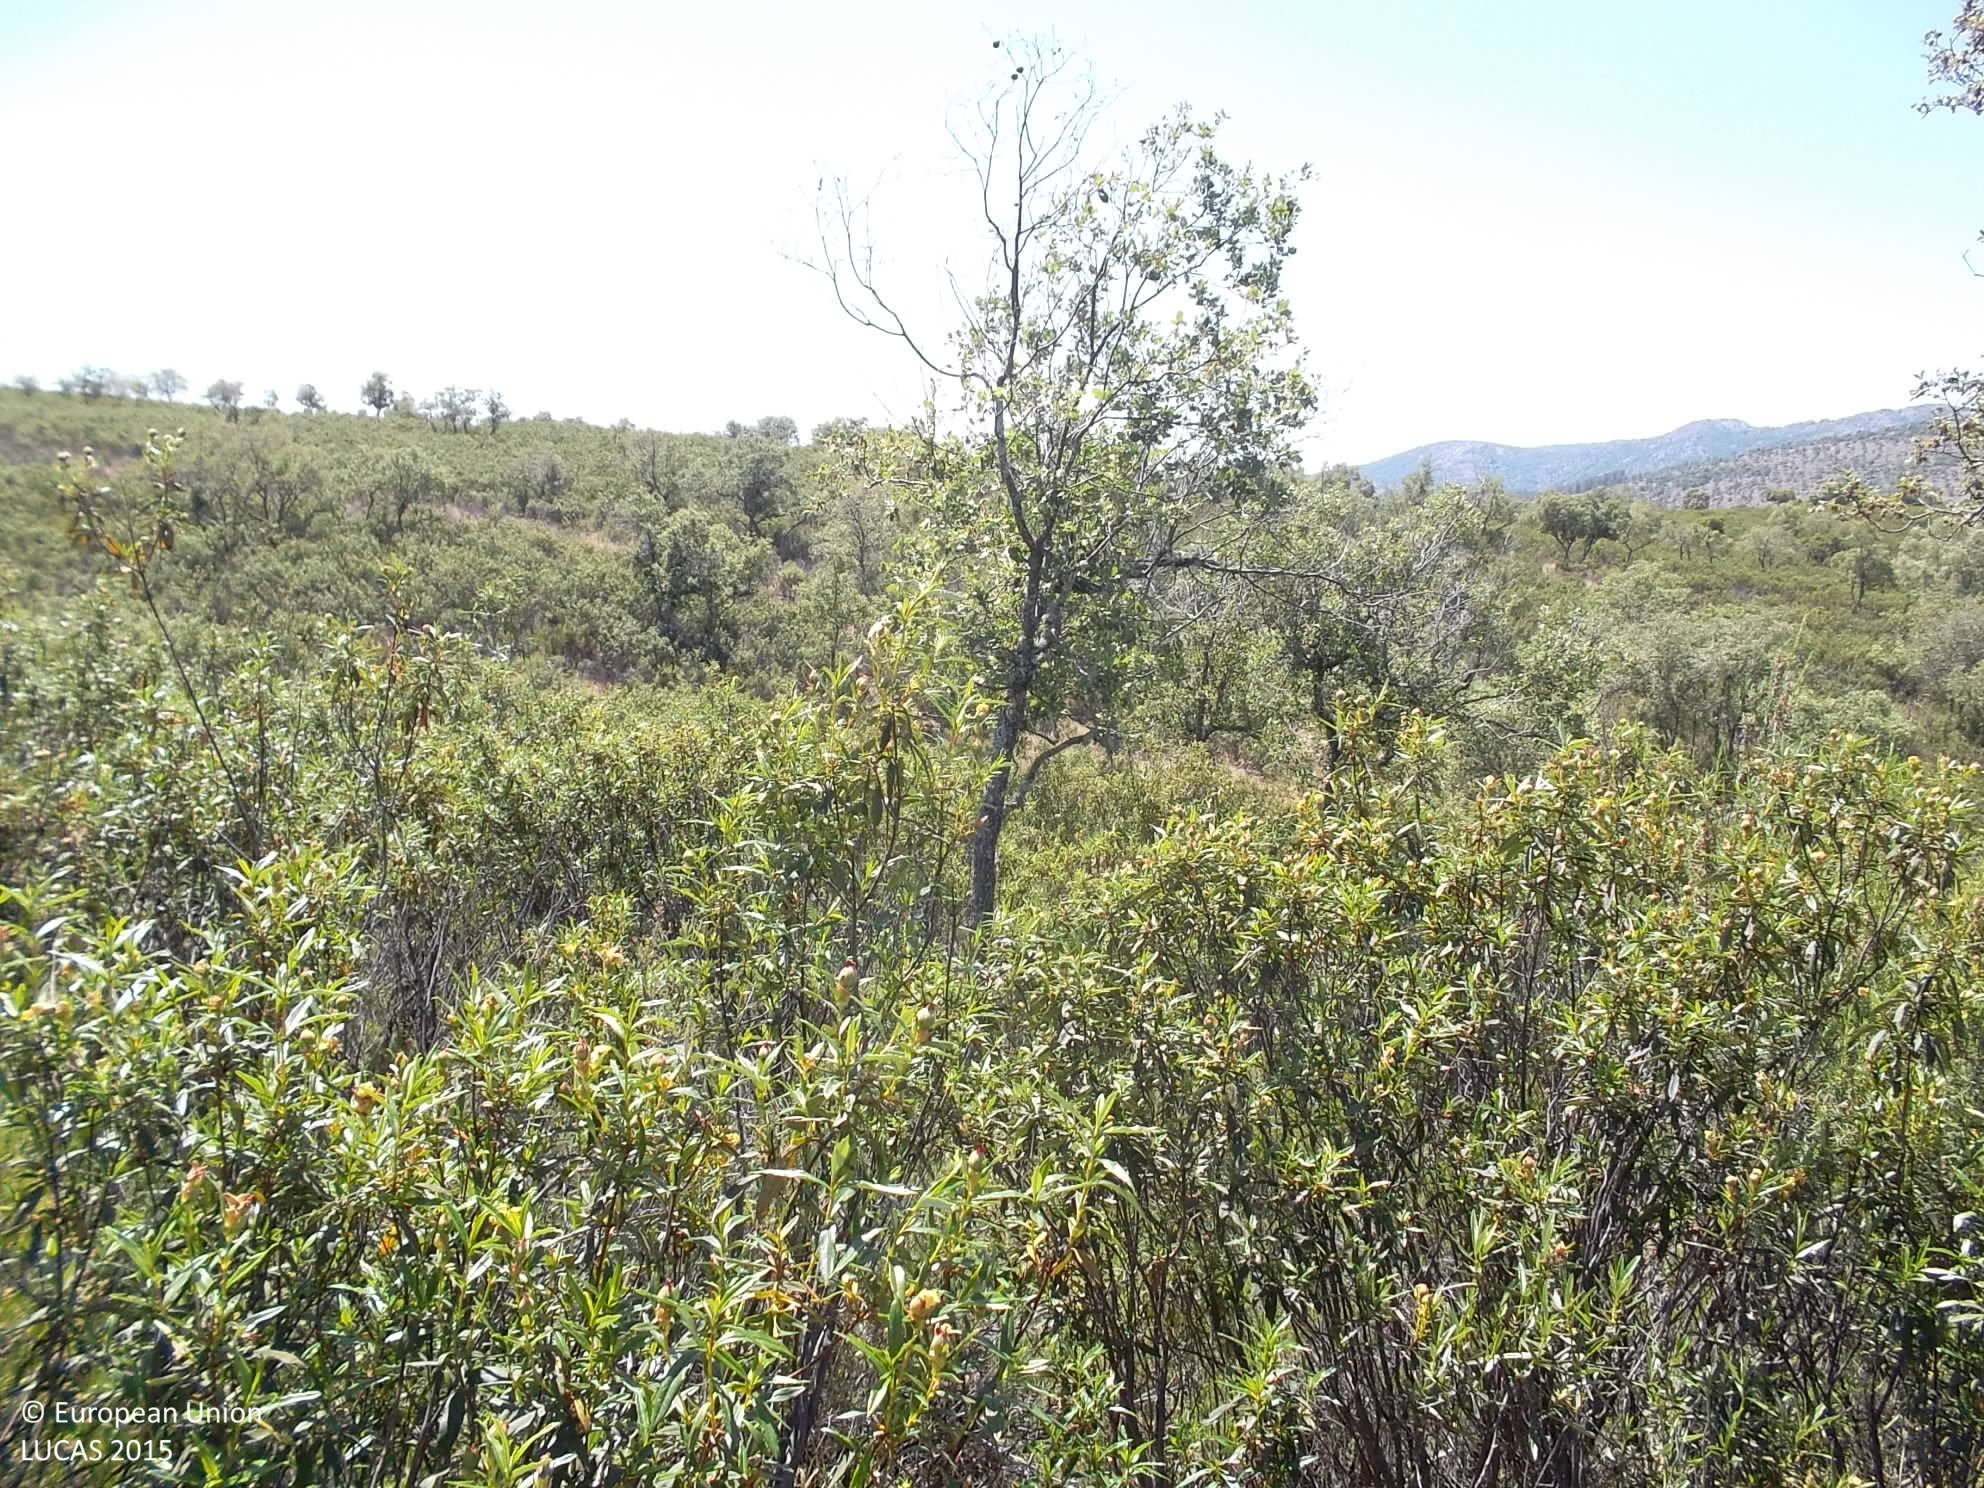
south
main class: Shrubland
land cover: Shrubland with sparse tree cover
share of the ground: > 75 %
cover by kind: shrubs 95 %, broadleaved forest trees 5 %
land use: Forestry
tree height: < 5 m
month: May
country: ES
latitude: 38.5211
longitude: -4.3910
